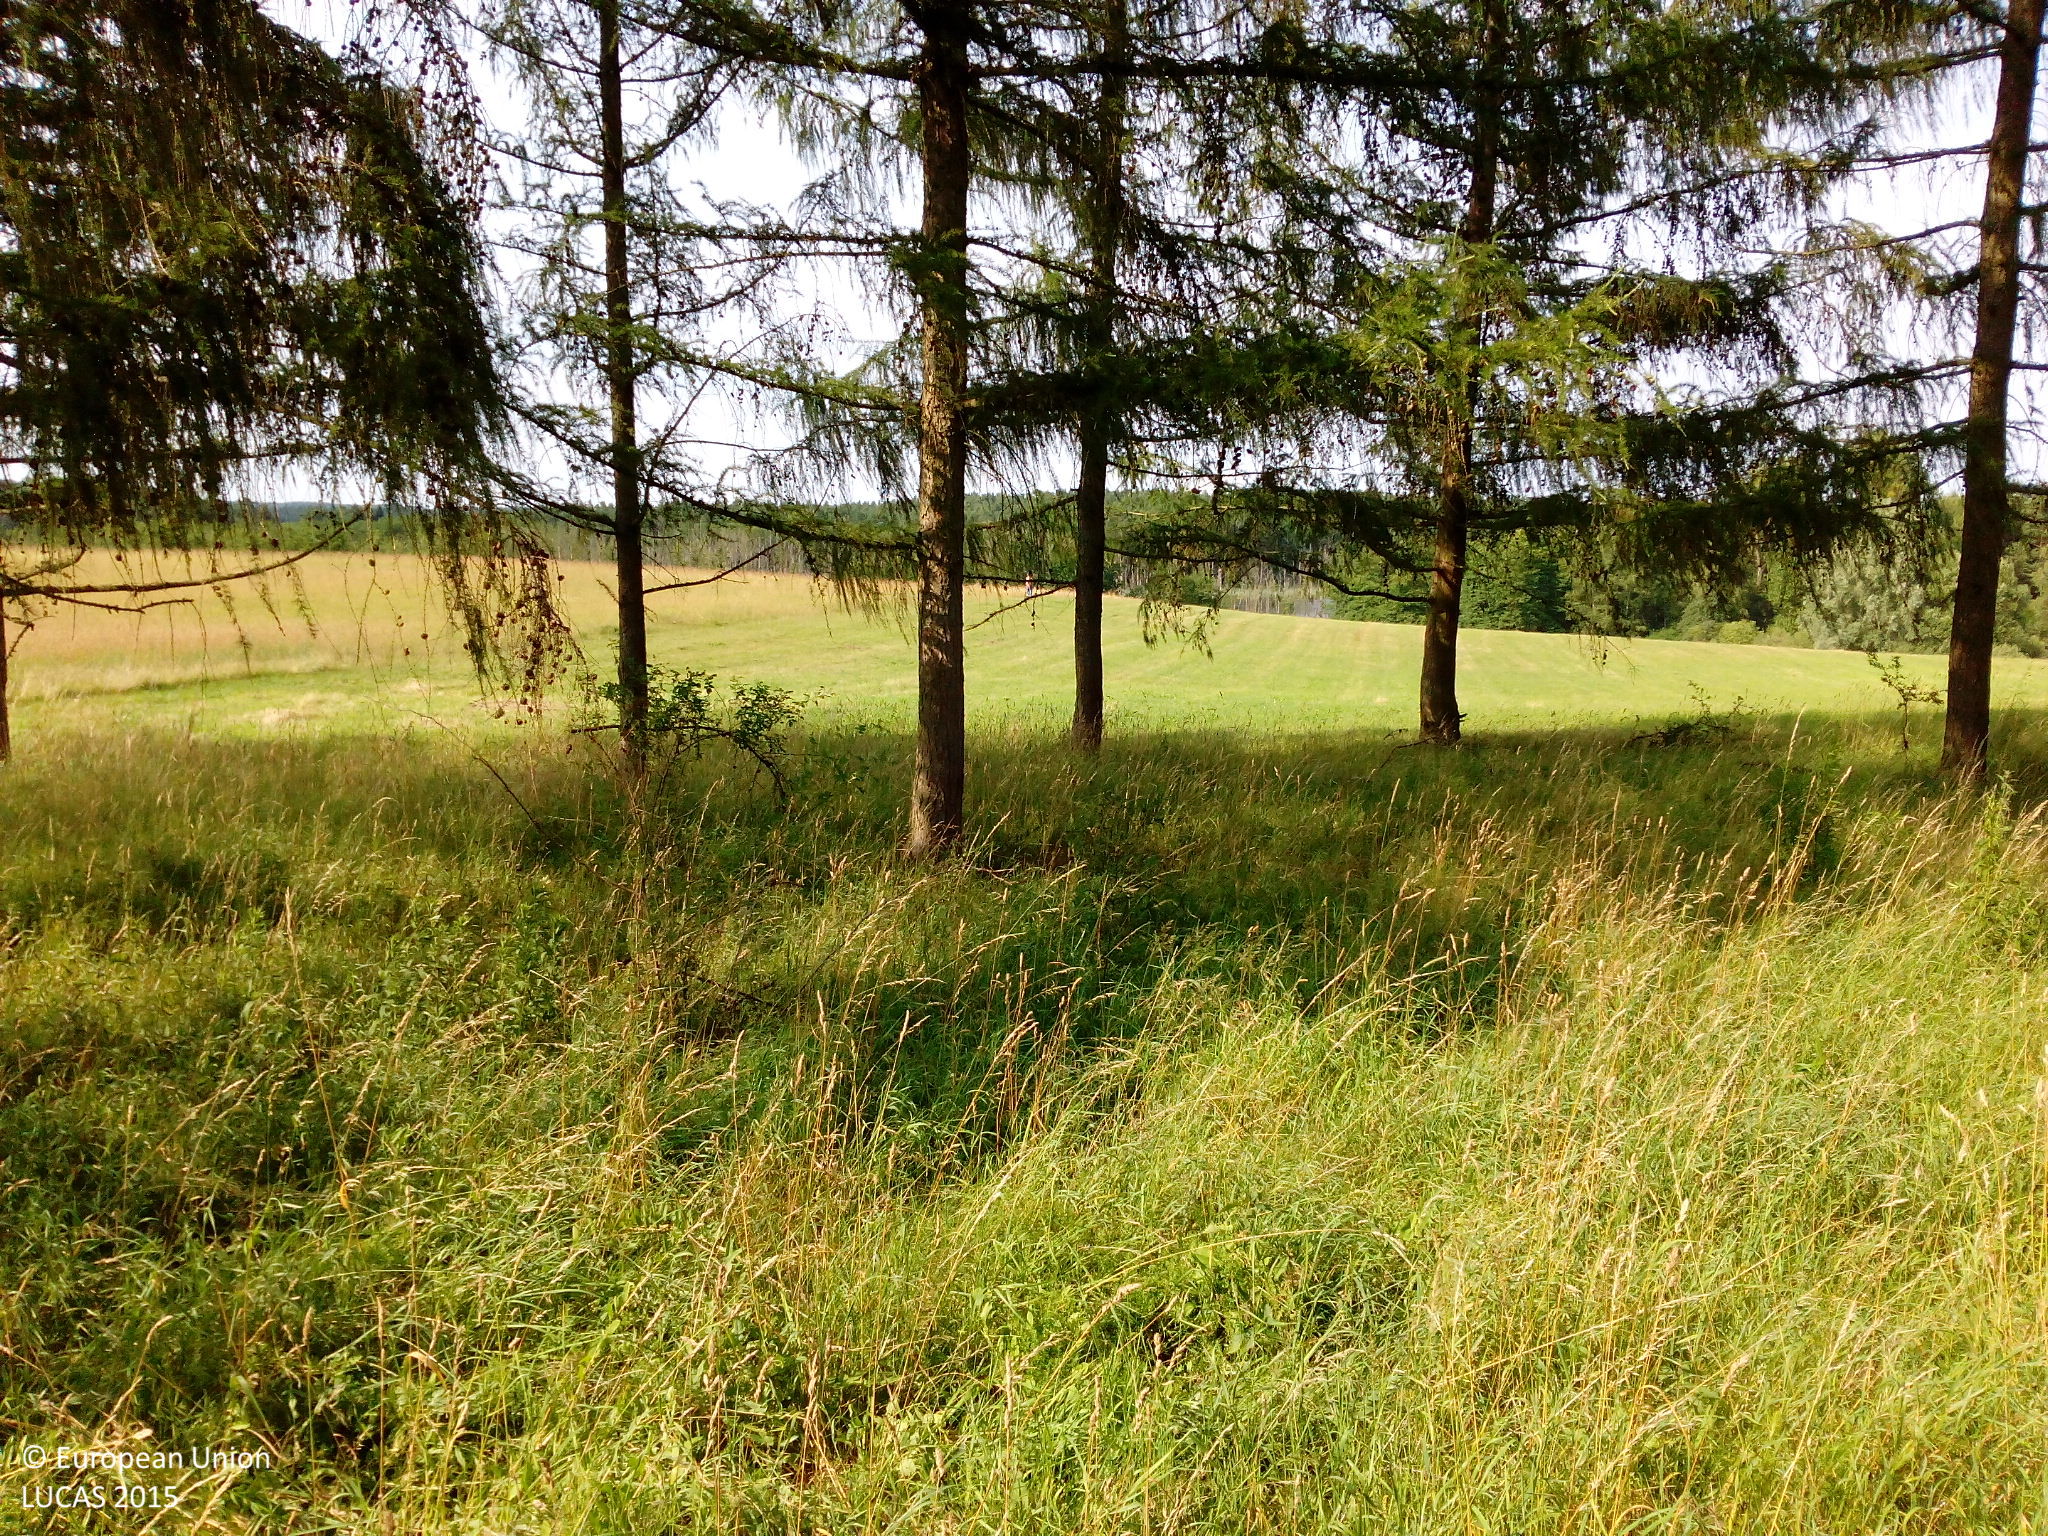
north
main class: Woodland
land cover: Other coniferous woodland
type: hemiboreal forest and nemoral coniferous forest and mixed broadleaved-coniferous forest
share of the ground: 50 - 75 %
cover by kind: coniferous forest trees 70 %, herbaceous plants 30 %
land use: Forestry
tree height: > 5 m
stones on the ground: < 10 %
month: July
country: DE
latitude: 52.5402
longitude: 14.1146
